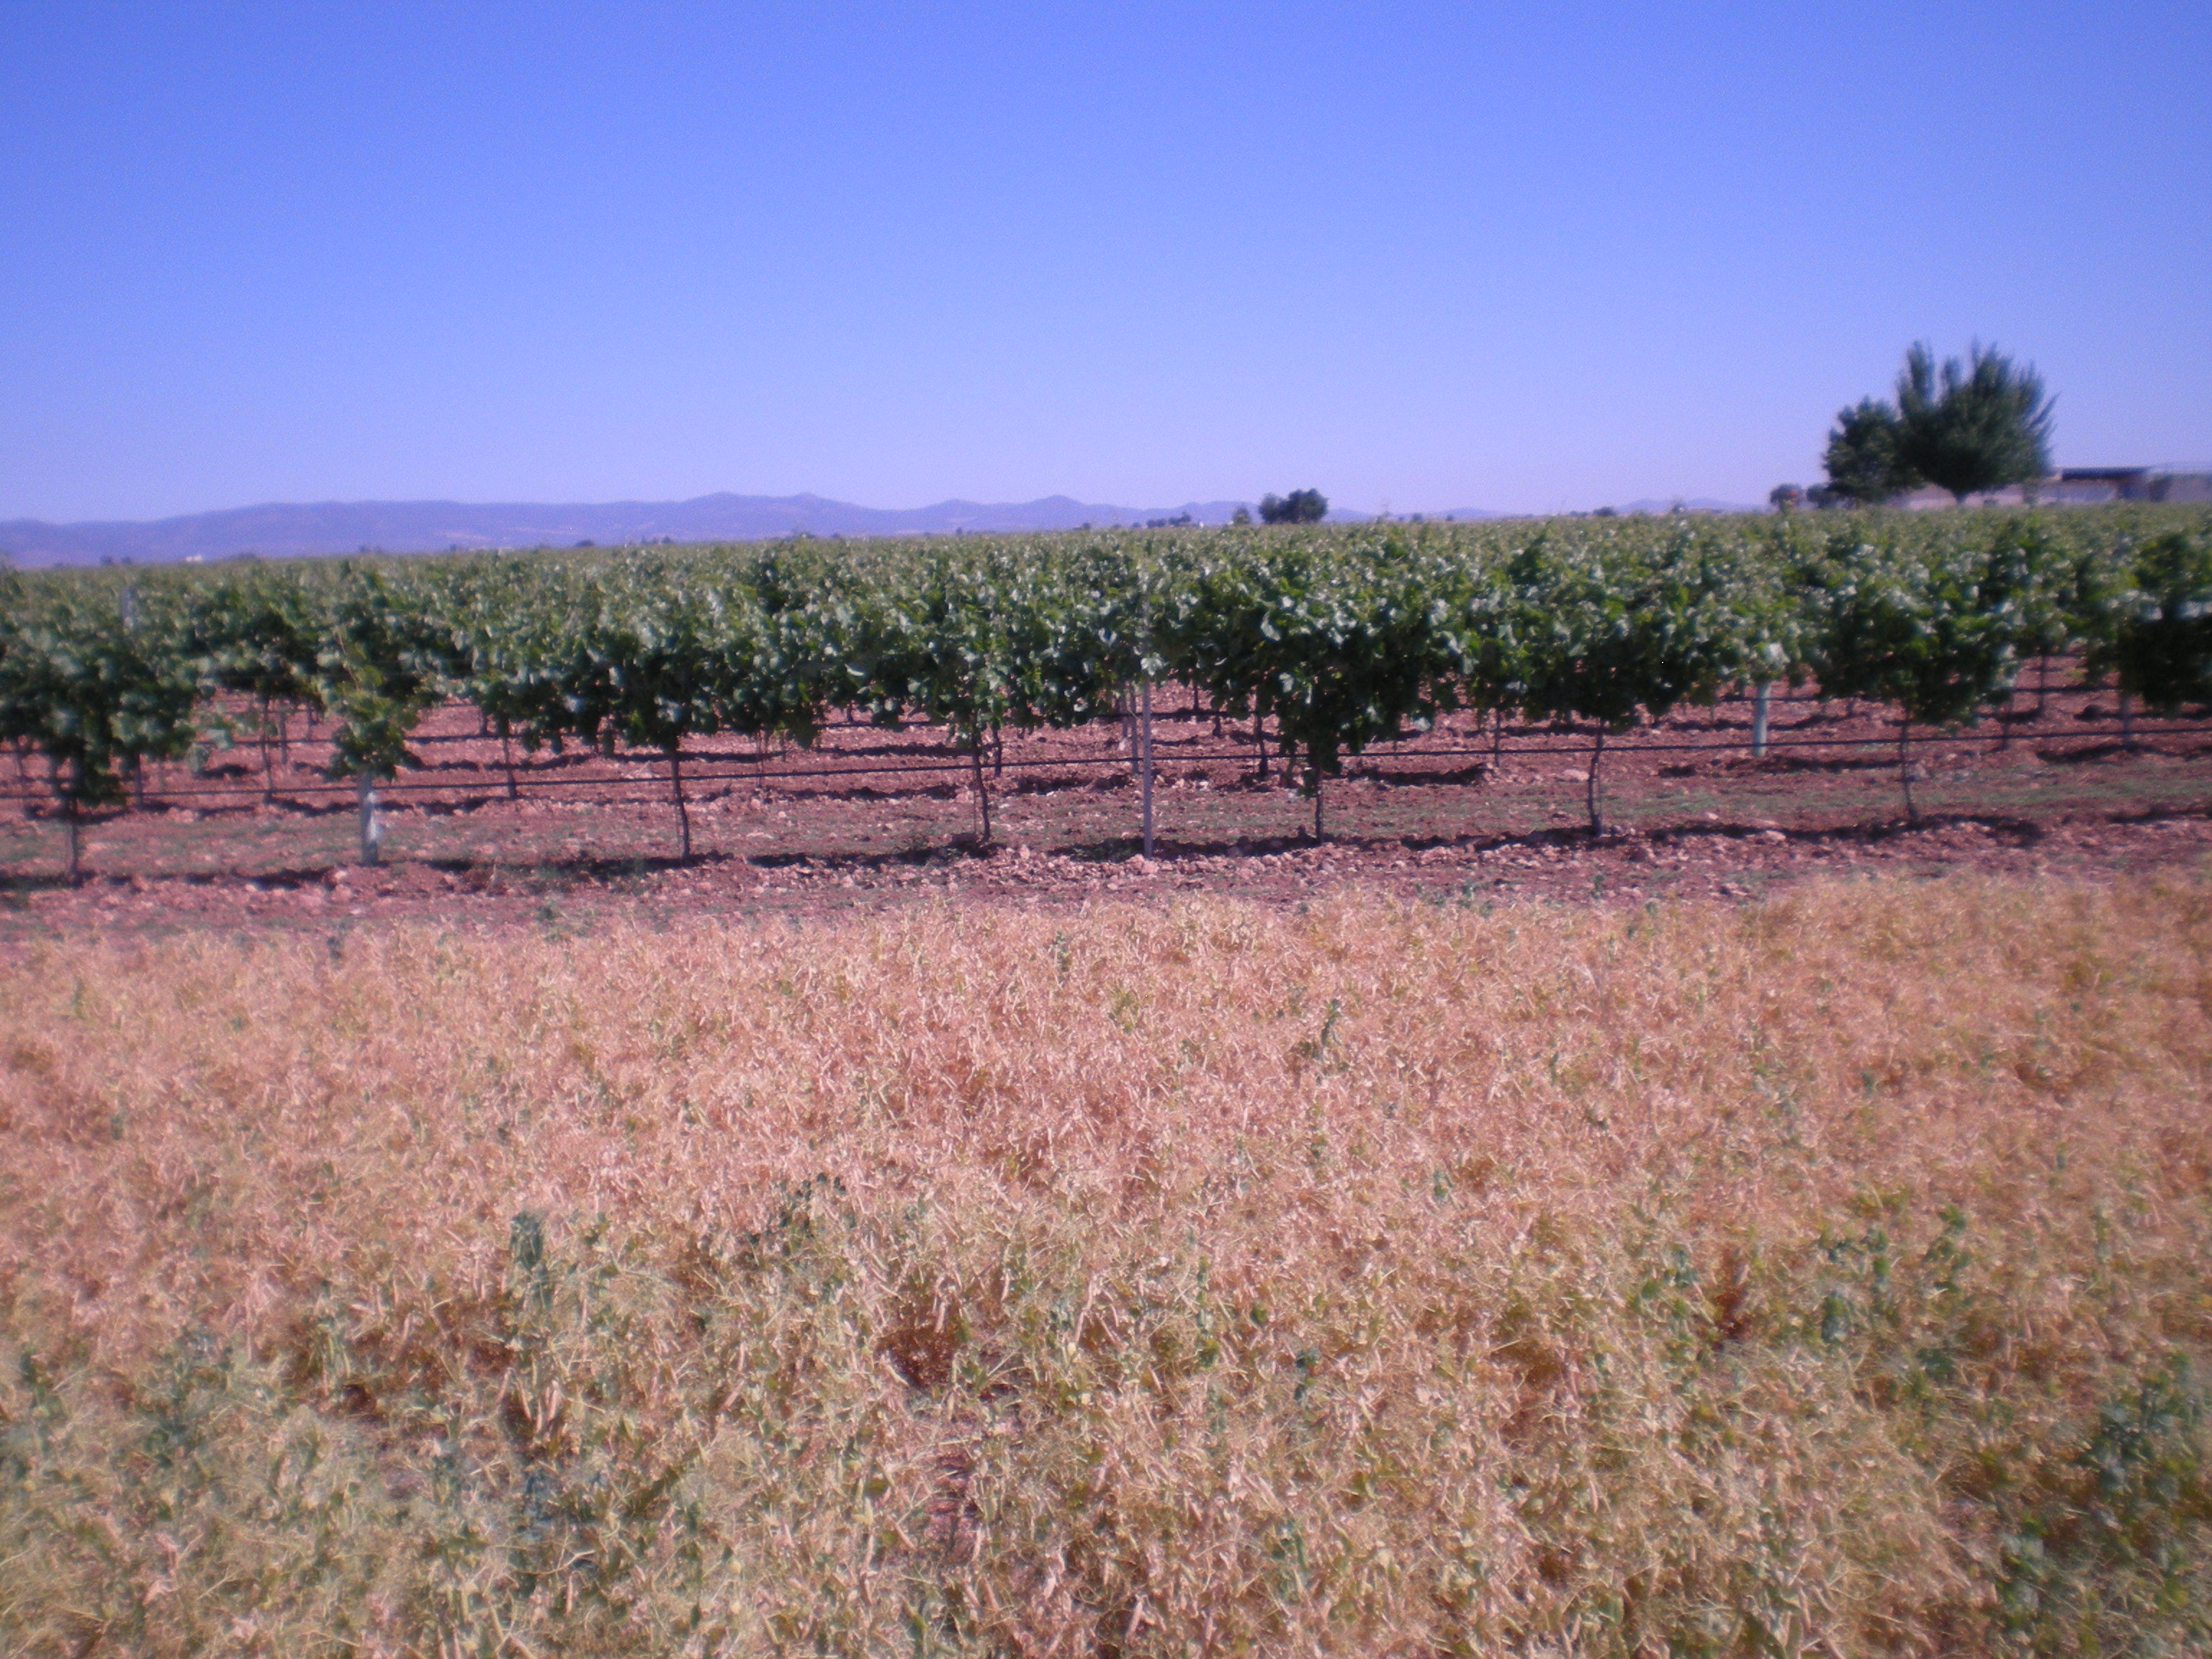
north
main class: Cropland
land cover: Dry pulses
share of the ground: > 75 %
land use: Agriculture (excluding fallow land and kitchen gardens)
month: May
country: ES
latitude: 39.0869
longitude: -3.5319
